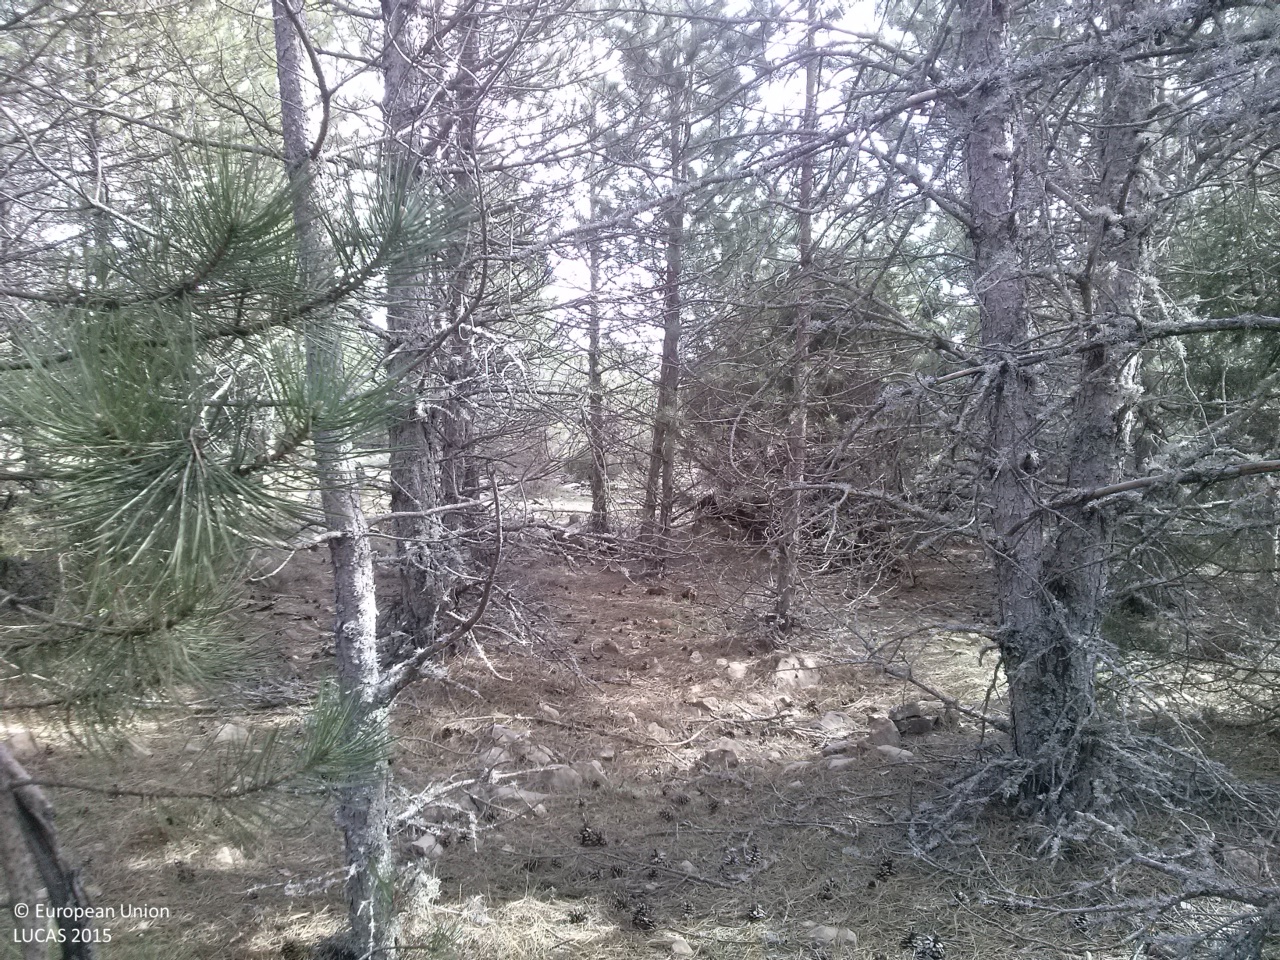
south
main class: Woodland
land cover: Pine dominated coniferous woodland
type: coniferous forest of the mediterranean region
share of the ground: 50 - 75 %
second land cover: Grassland without tree/shrub cover
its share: 10 - 25 %
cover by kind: coniferous forest trees 70 %, herbaceous plants 25 %, shrubs 5 %
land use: Forestry
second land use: Agriculture (excluding fallow land and kitchen gardens)
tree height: > 5 m
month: April
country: ES
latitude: 40.0918
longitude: -1.8717
